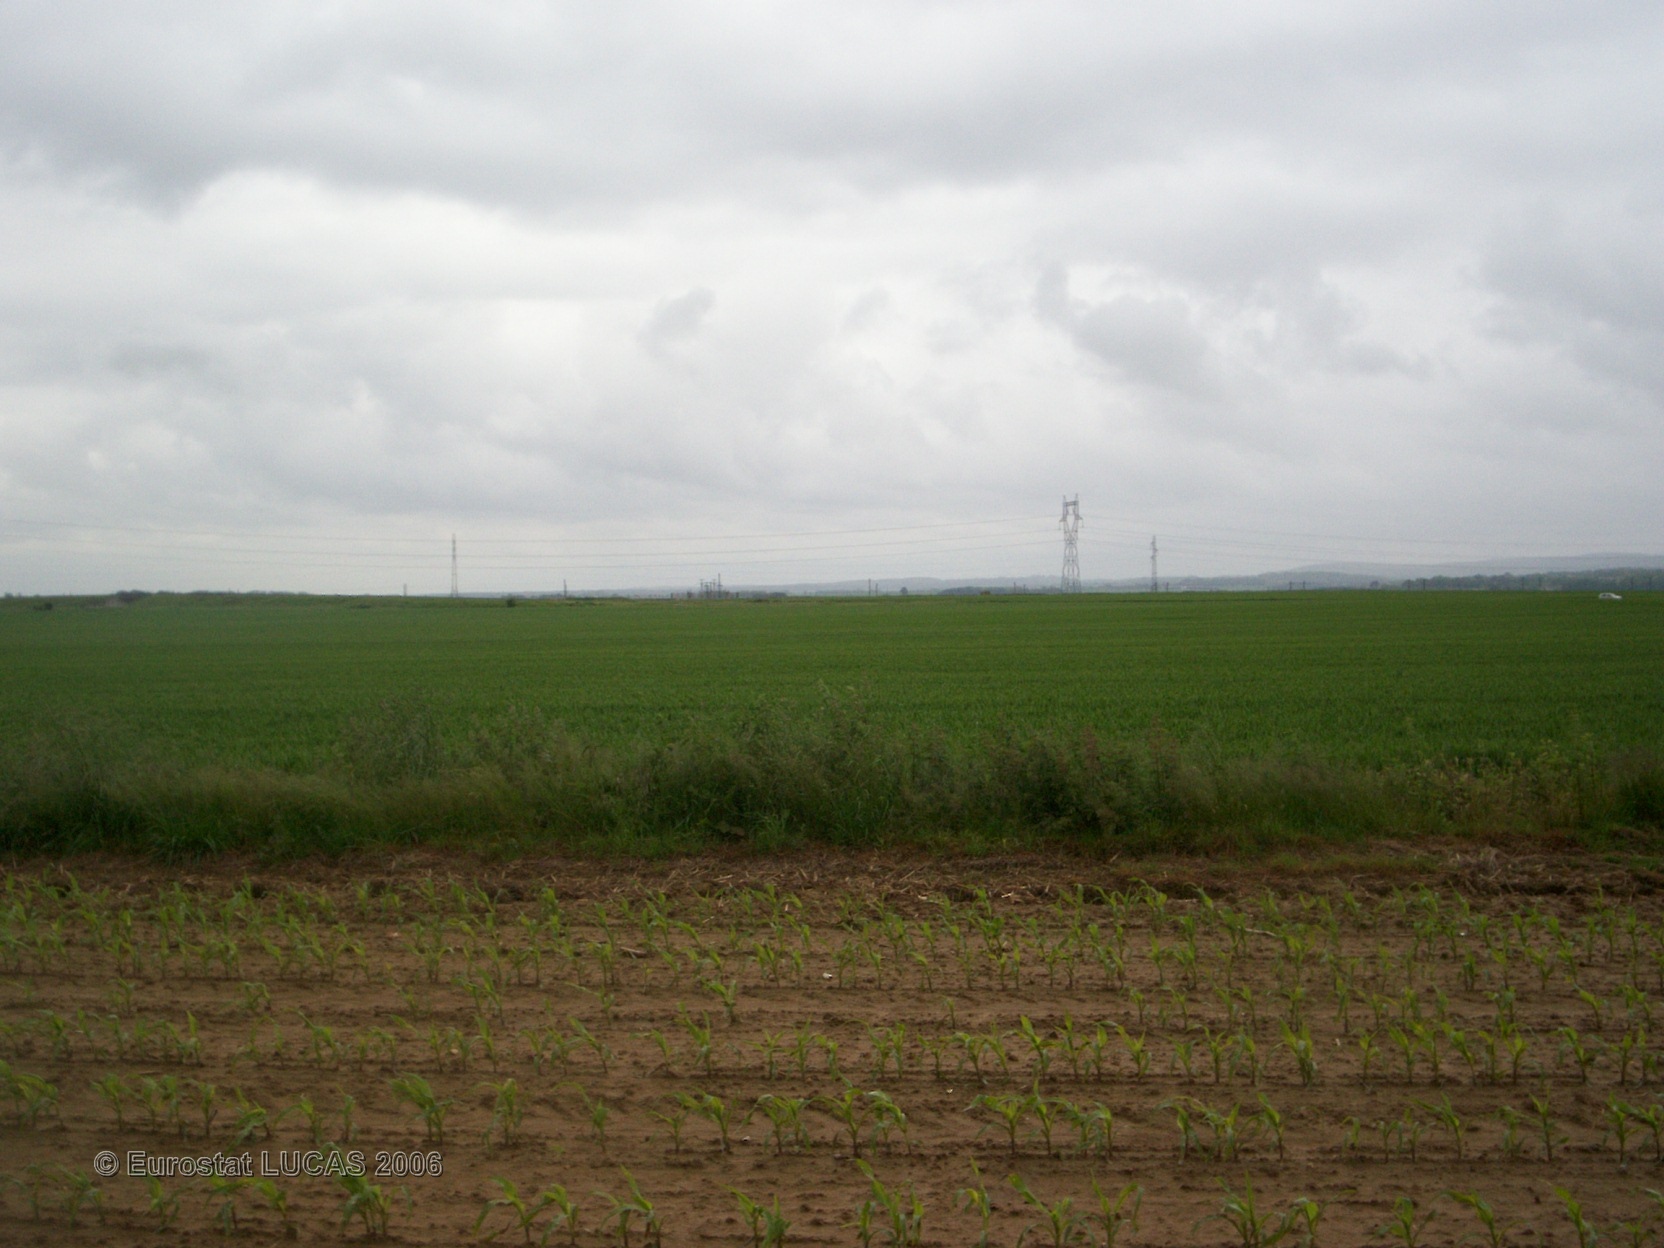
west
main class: Cropland
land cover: Maize
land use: Agriculture (excluding fallow land and kitchen gardens)
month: May
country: FR
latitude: 49.2491
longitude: 2.7498
